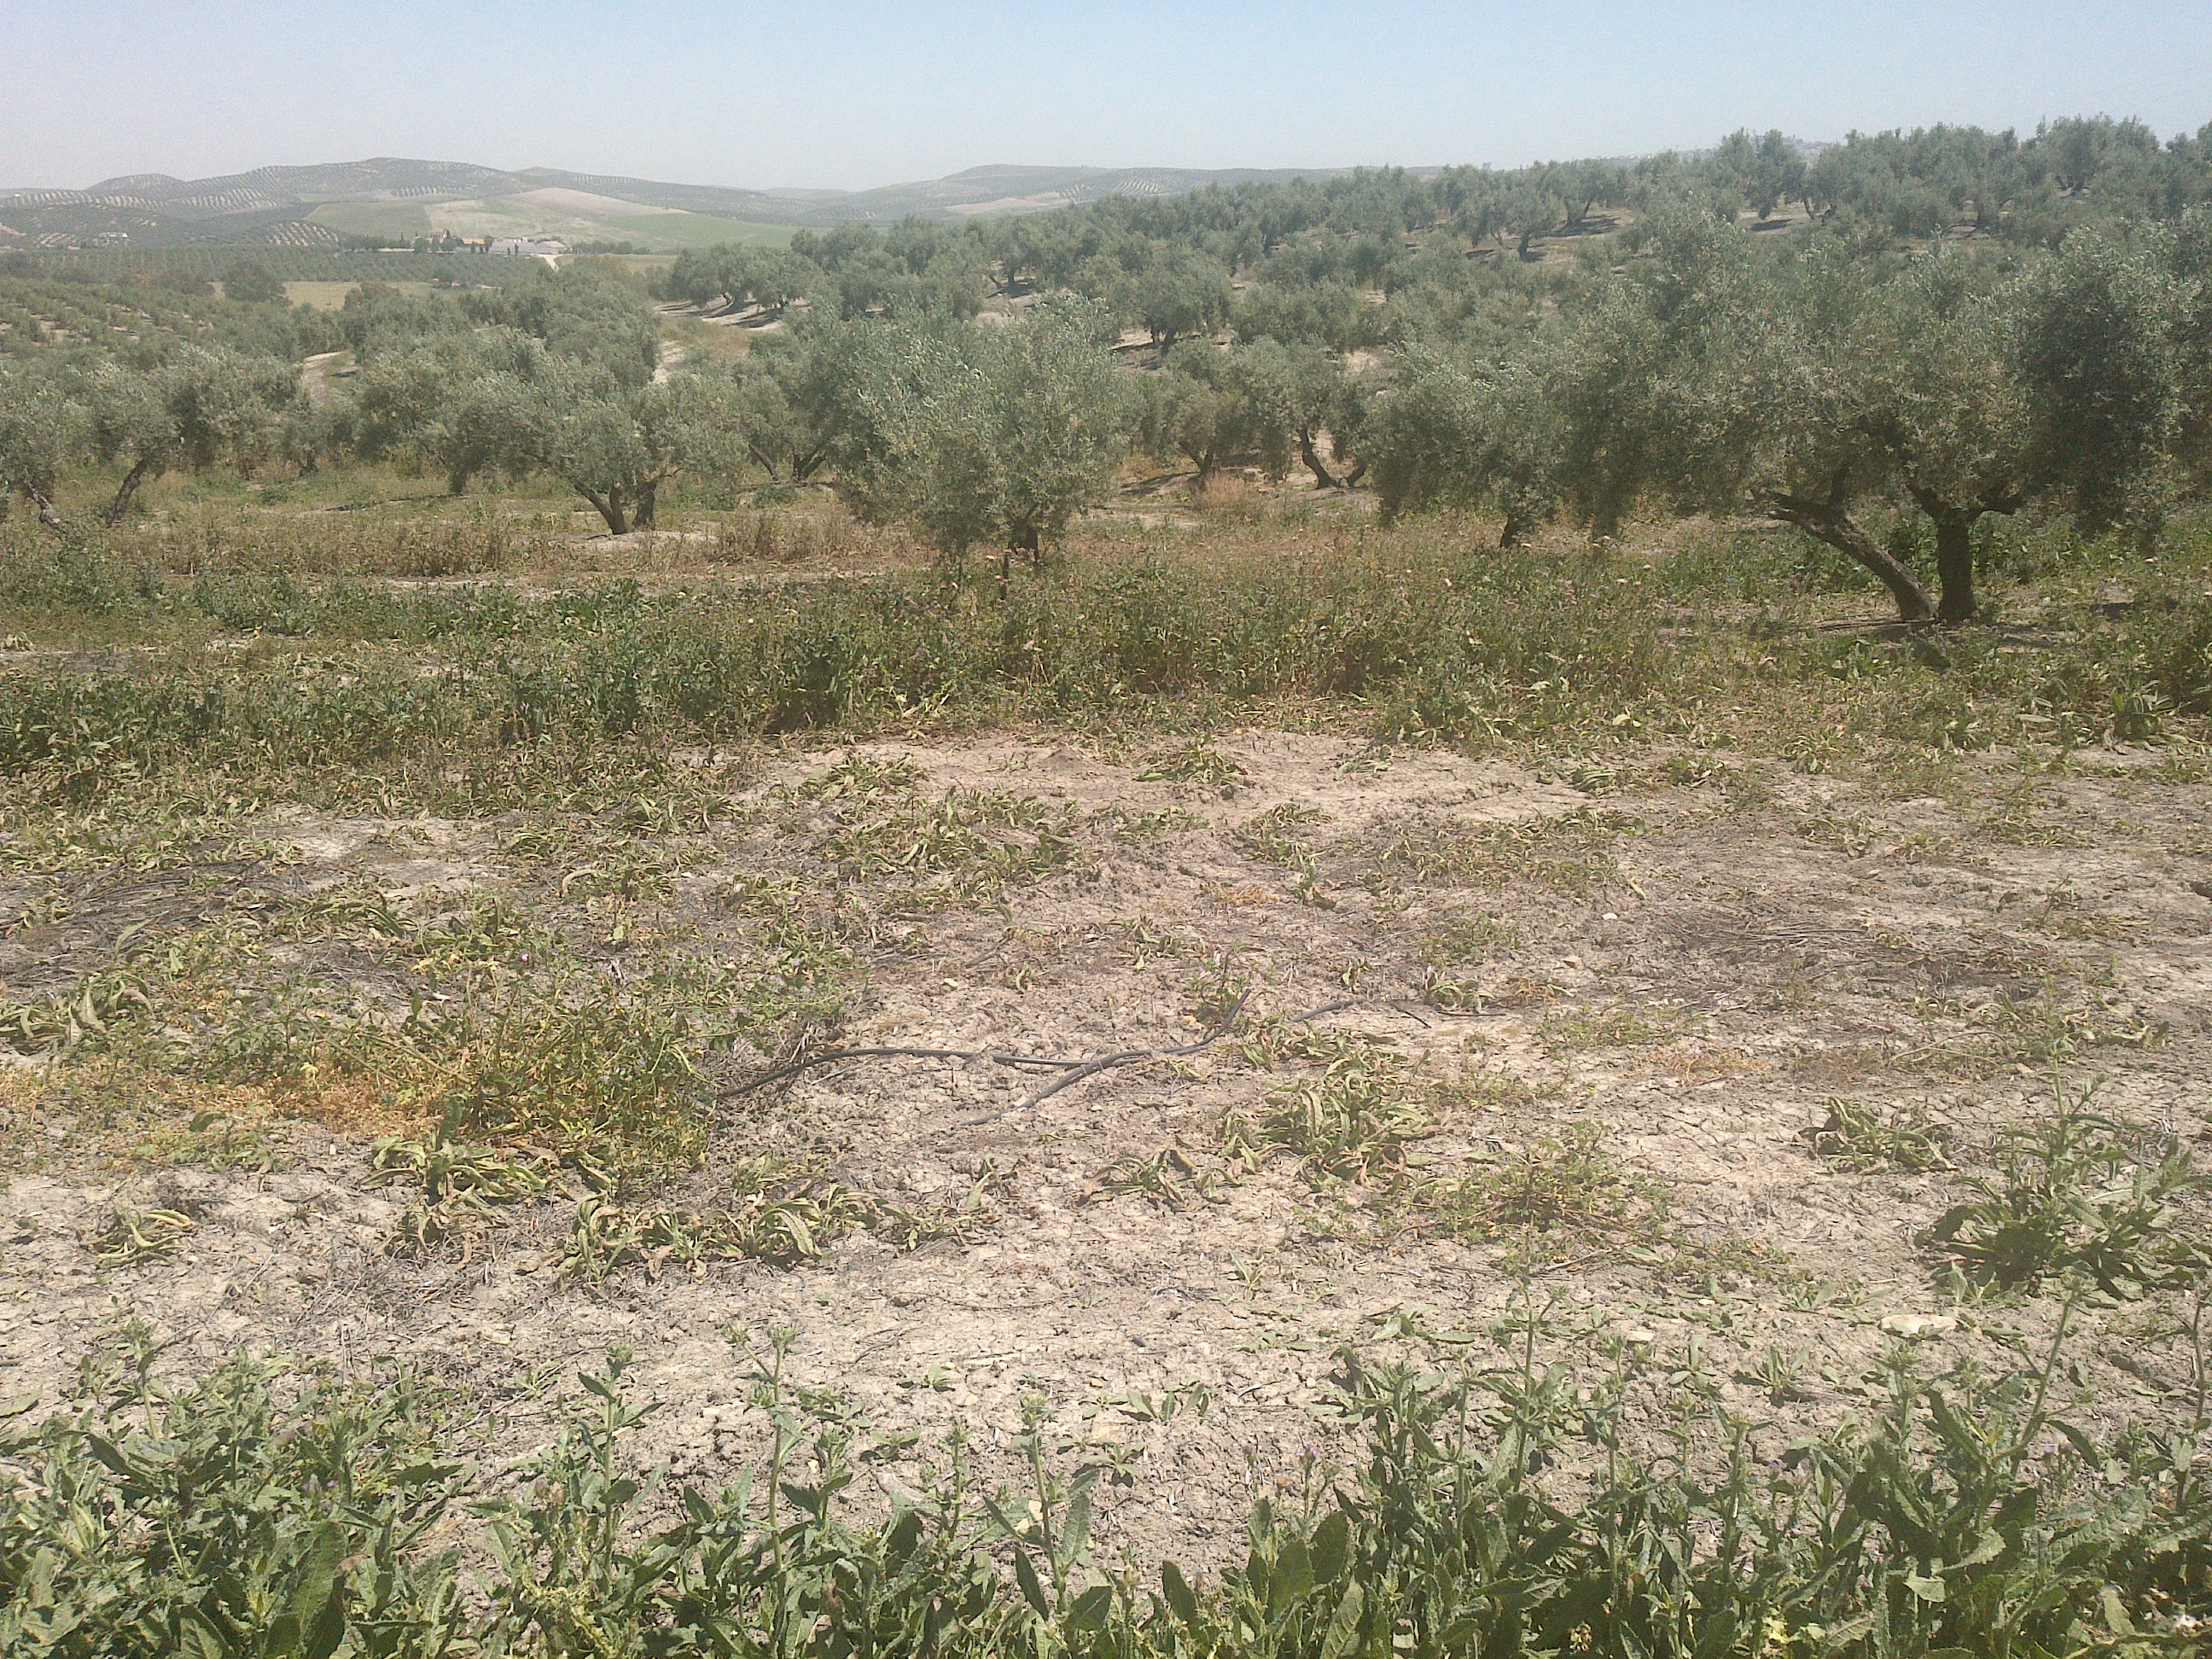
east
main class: Cropland
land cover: Olive groves
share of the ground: 25 - 50 %
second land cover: Spontaneously vegetated surfaces
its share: 10 - 25 %
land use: Agriculture (excluding fallow land and kitchen gardens)
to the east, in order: Olive groves; Spontaneously vegetated surfaces; Tracks; Olive groves
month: May
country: ES
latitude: 37.6948
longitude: -4.6278
